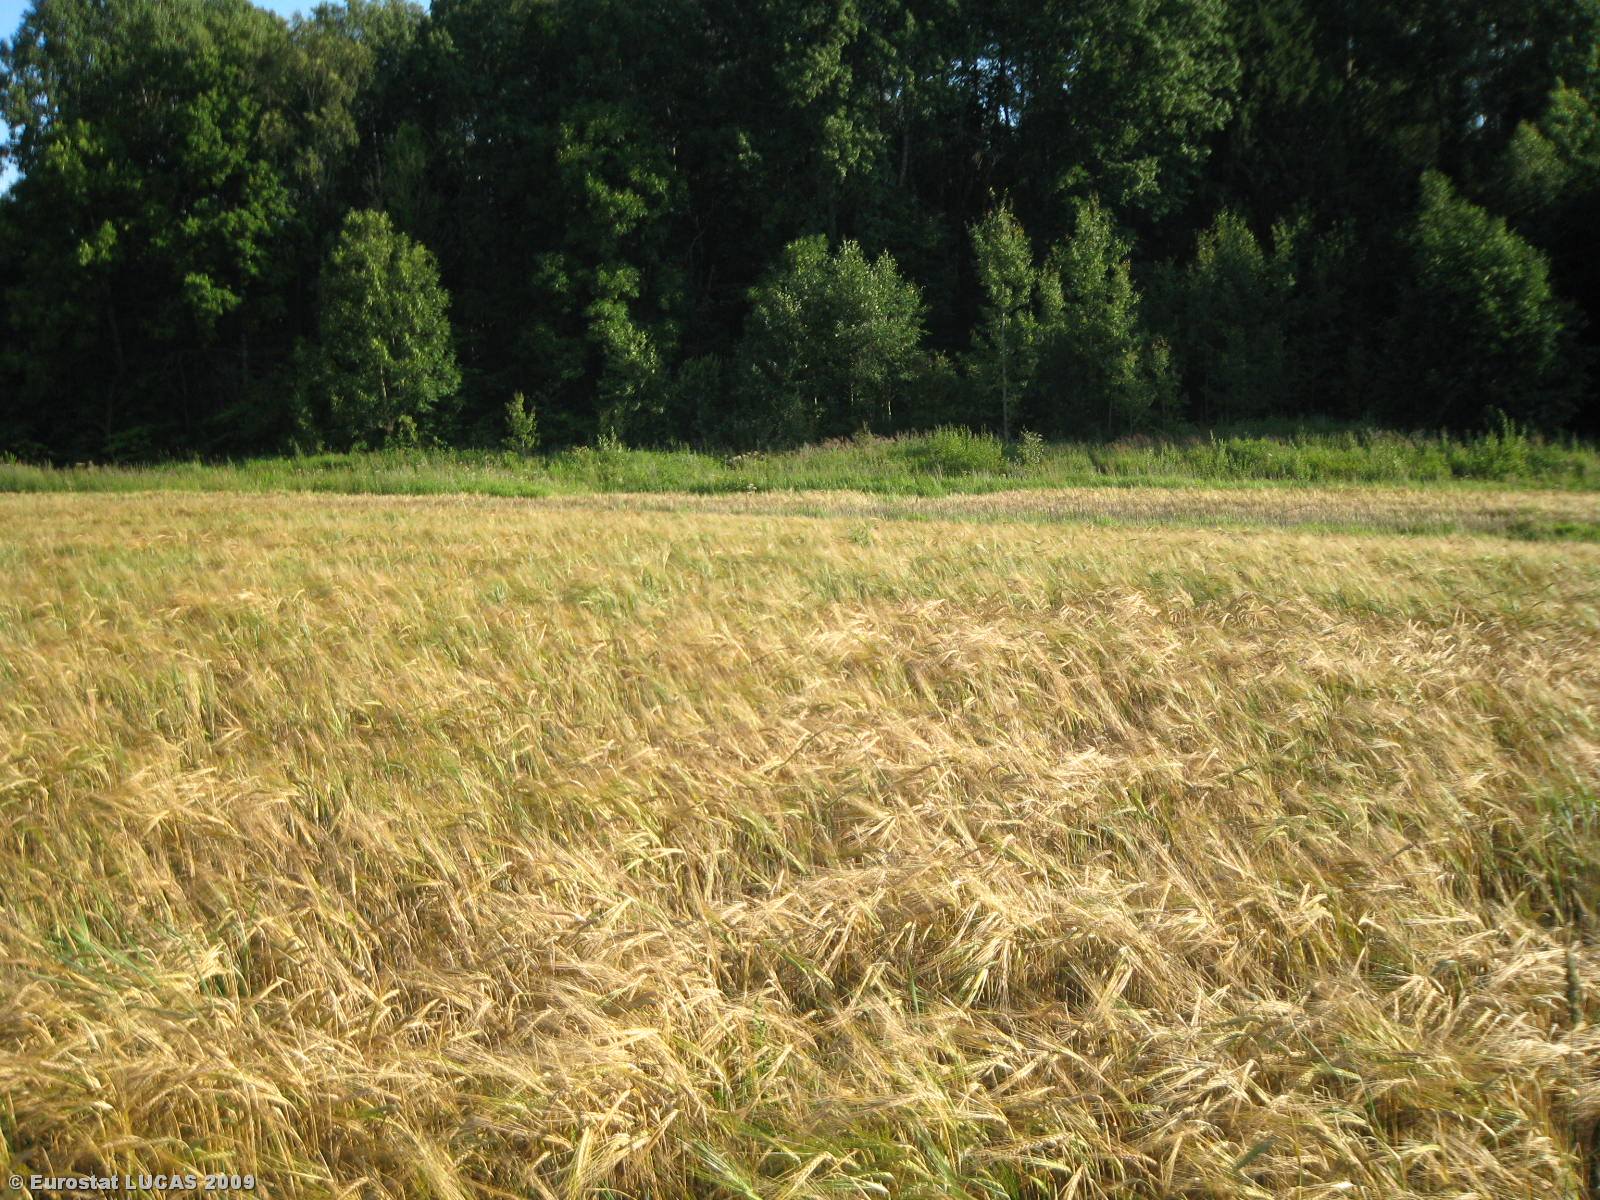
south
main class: Grassland
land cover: Grassland without tree/shrub cover
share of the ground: > 75 %
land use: Agriculture (excluding fallow land and kitchen gardens)
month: July
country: LT
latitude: 55.3505
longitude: 23.7581
